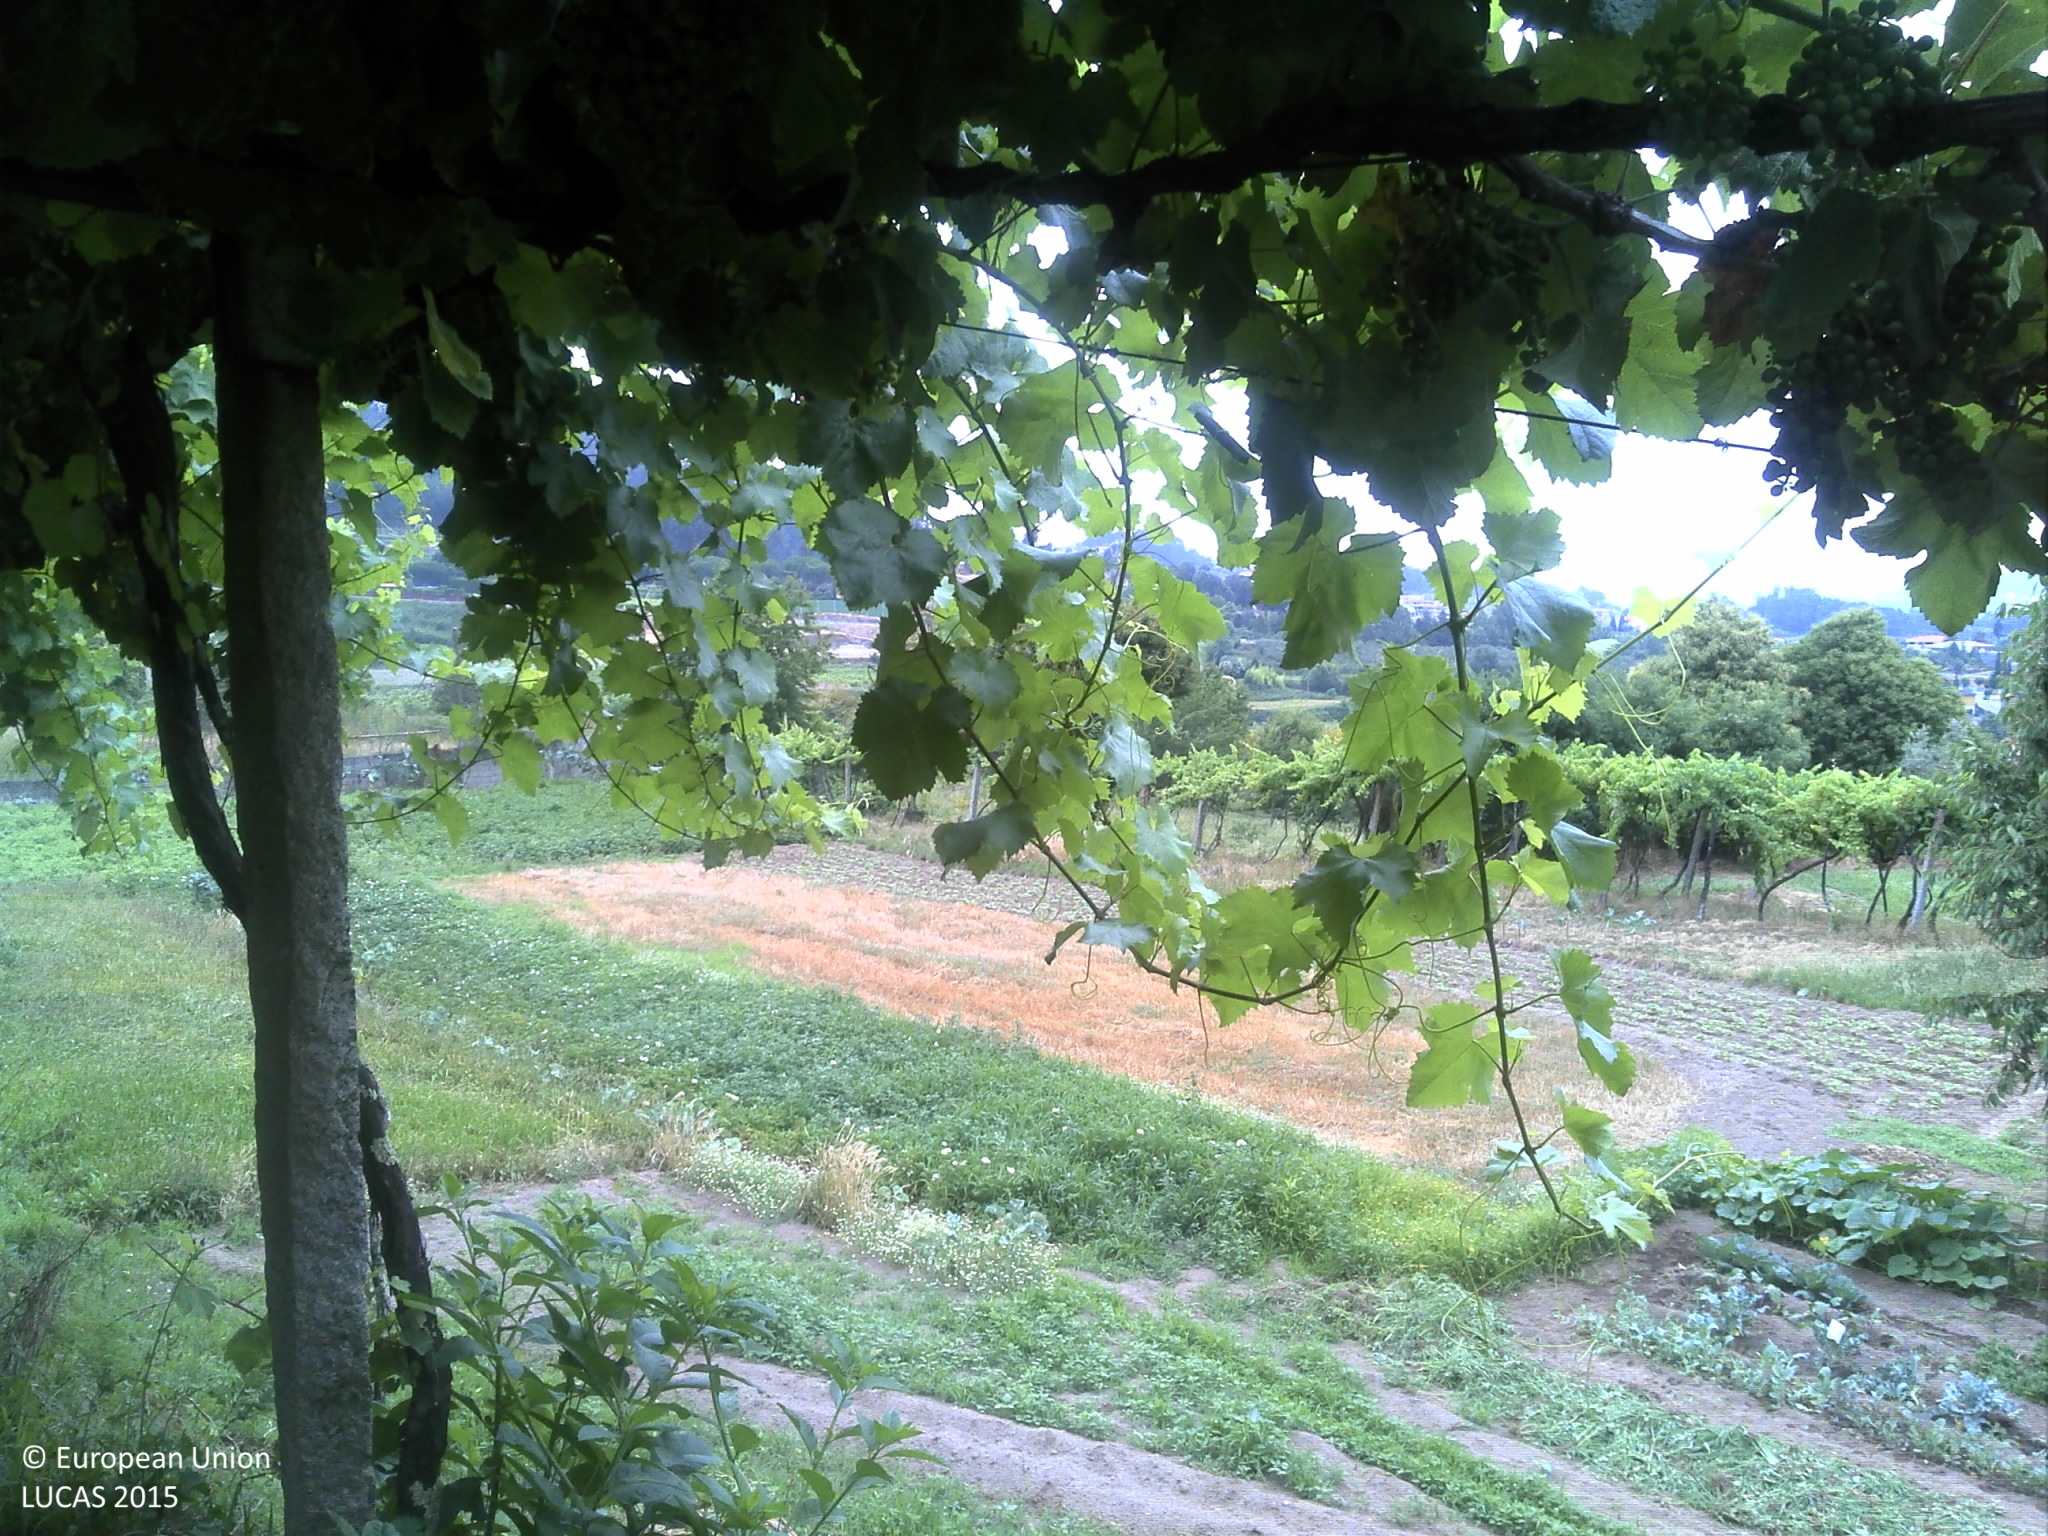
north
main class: Cropland
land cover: Vineyards
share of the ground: > 75 %
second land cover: Grassland without tree/shrub cover
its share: 10 - 25 %
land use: Agriculture (excluding fallow land and kitchen gardens)
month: June
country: PT
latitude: 41.2258
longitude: -8.2152
